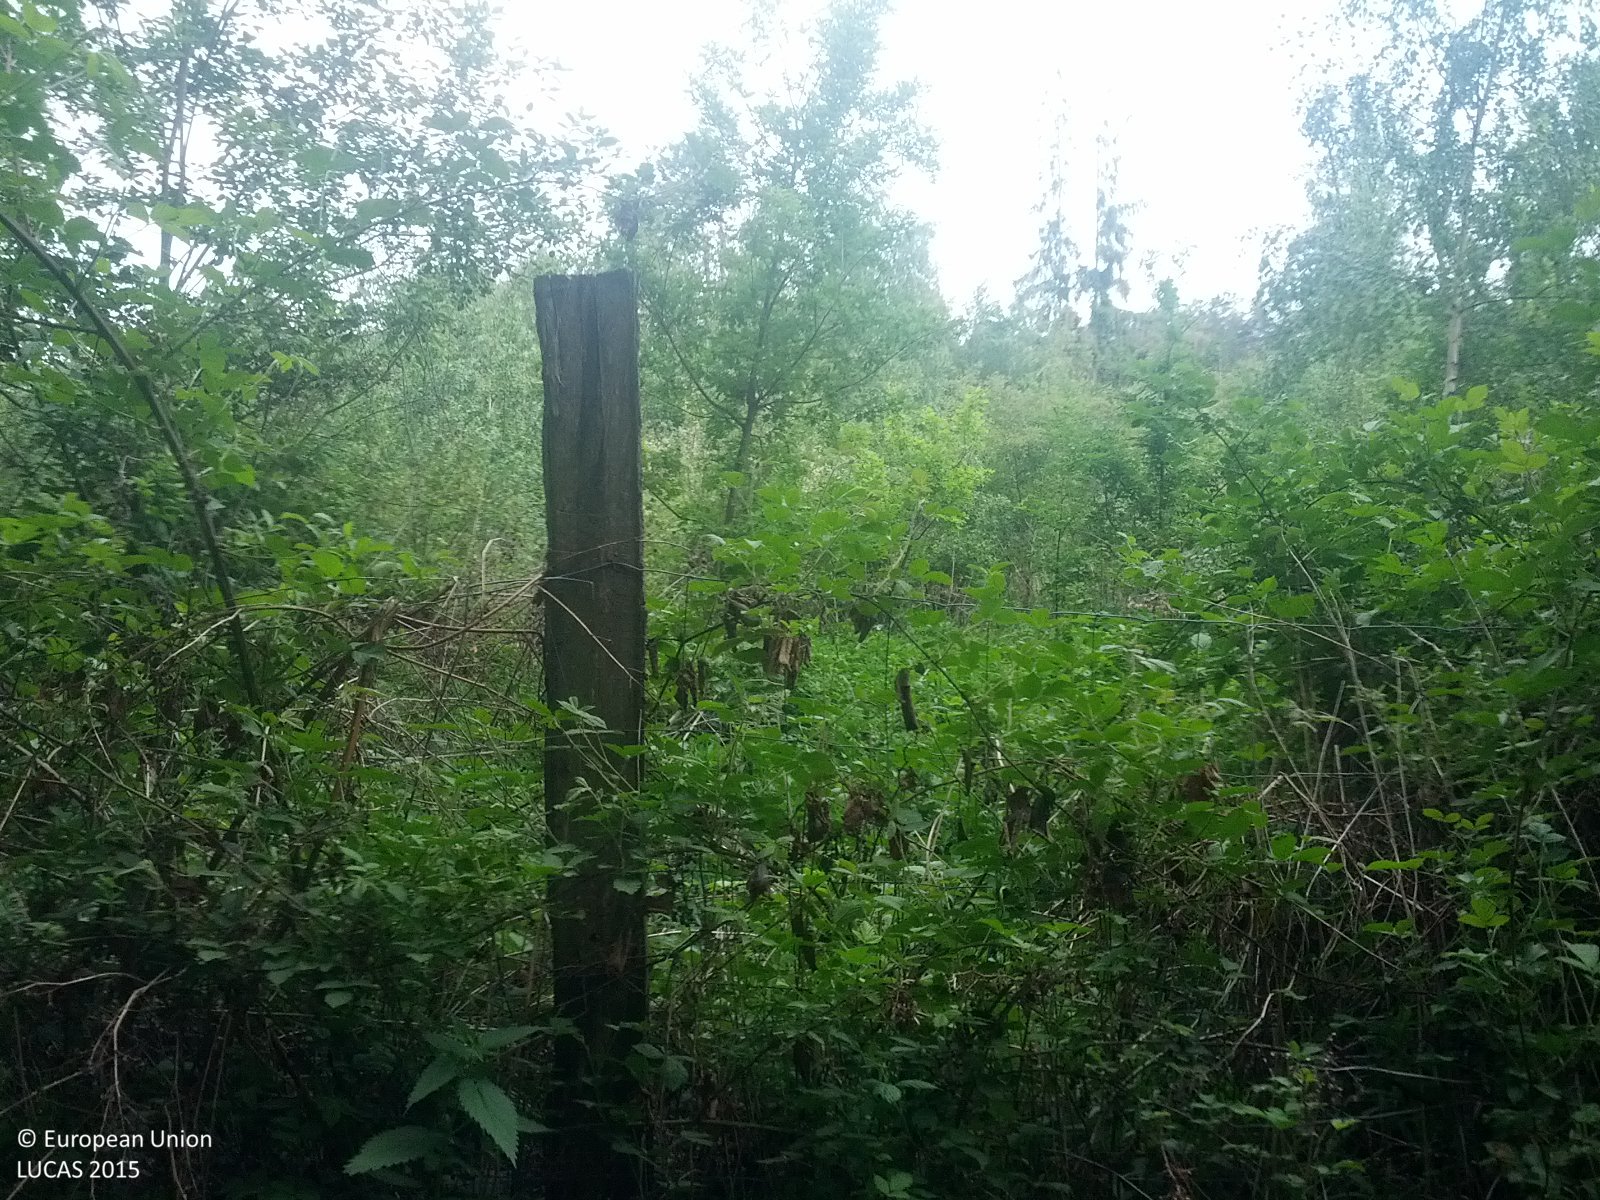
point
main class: Woodland
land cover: Broadleaved woodland
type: beech forest
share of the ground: > 75 %
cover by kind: broadleaved forest trees 60 %, shrubs 30 %, coniferous forest trees 5 %, herbaceous plants 5 %
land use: Forestry
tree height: < 5 m
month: May
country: AT
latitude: 47.2952
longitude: 16.1248
